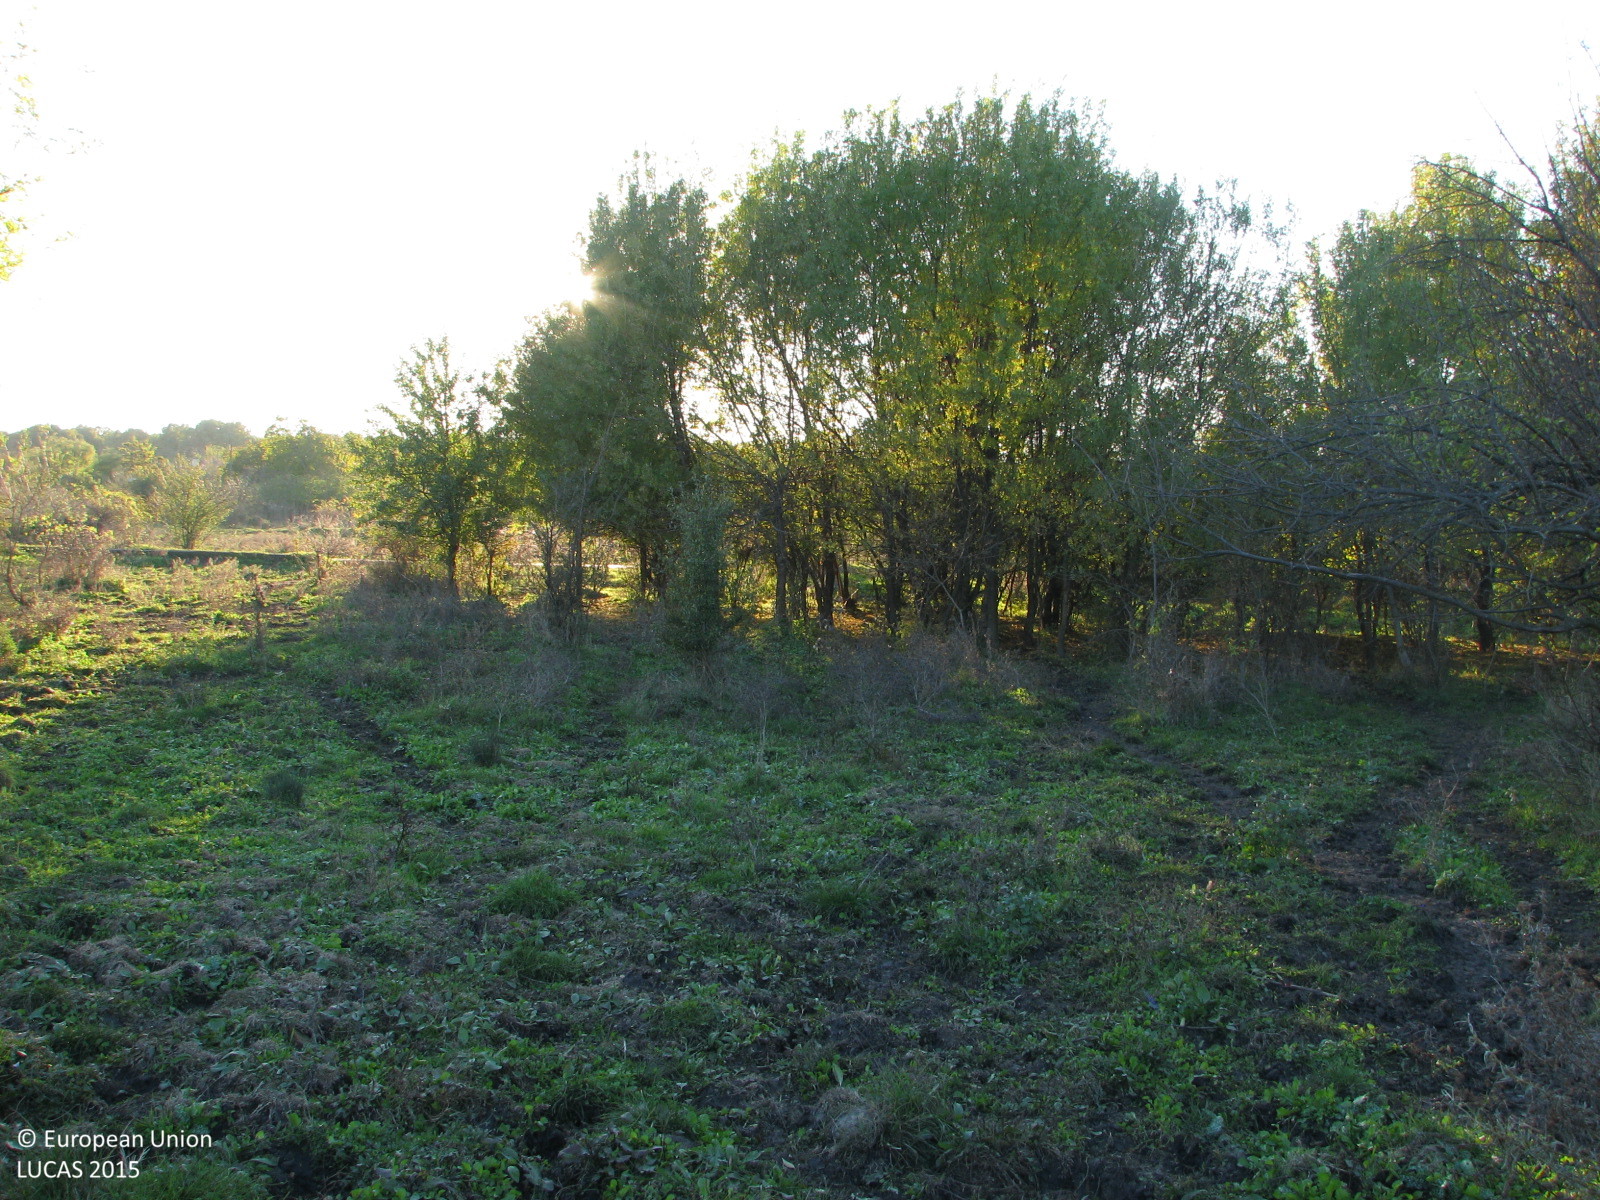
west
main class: Grassland
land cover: Spontaneously vegetated surfaces
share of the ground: > 75 %
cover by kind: herbaceous plants 95 %, consolidated bare surface 5 %
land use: Agriculture (excluding fallow land and kitchen gardens)
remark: Harvested field
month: November
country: BG
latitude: 42.1210
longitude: 26.6995
